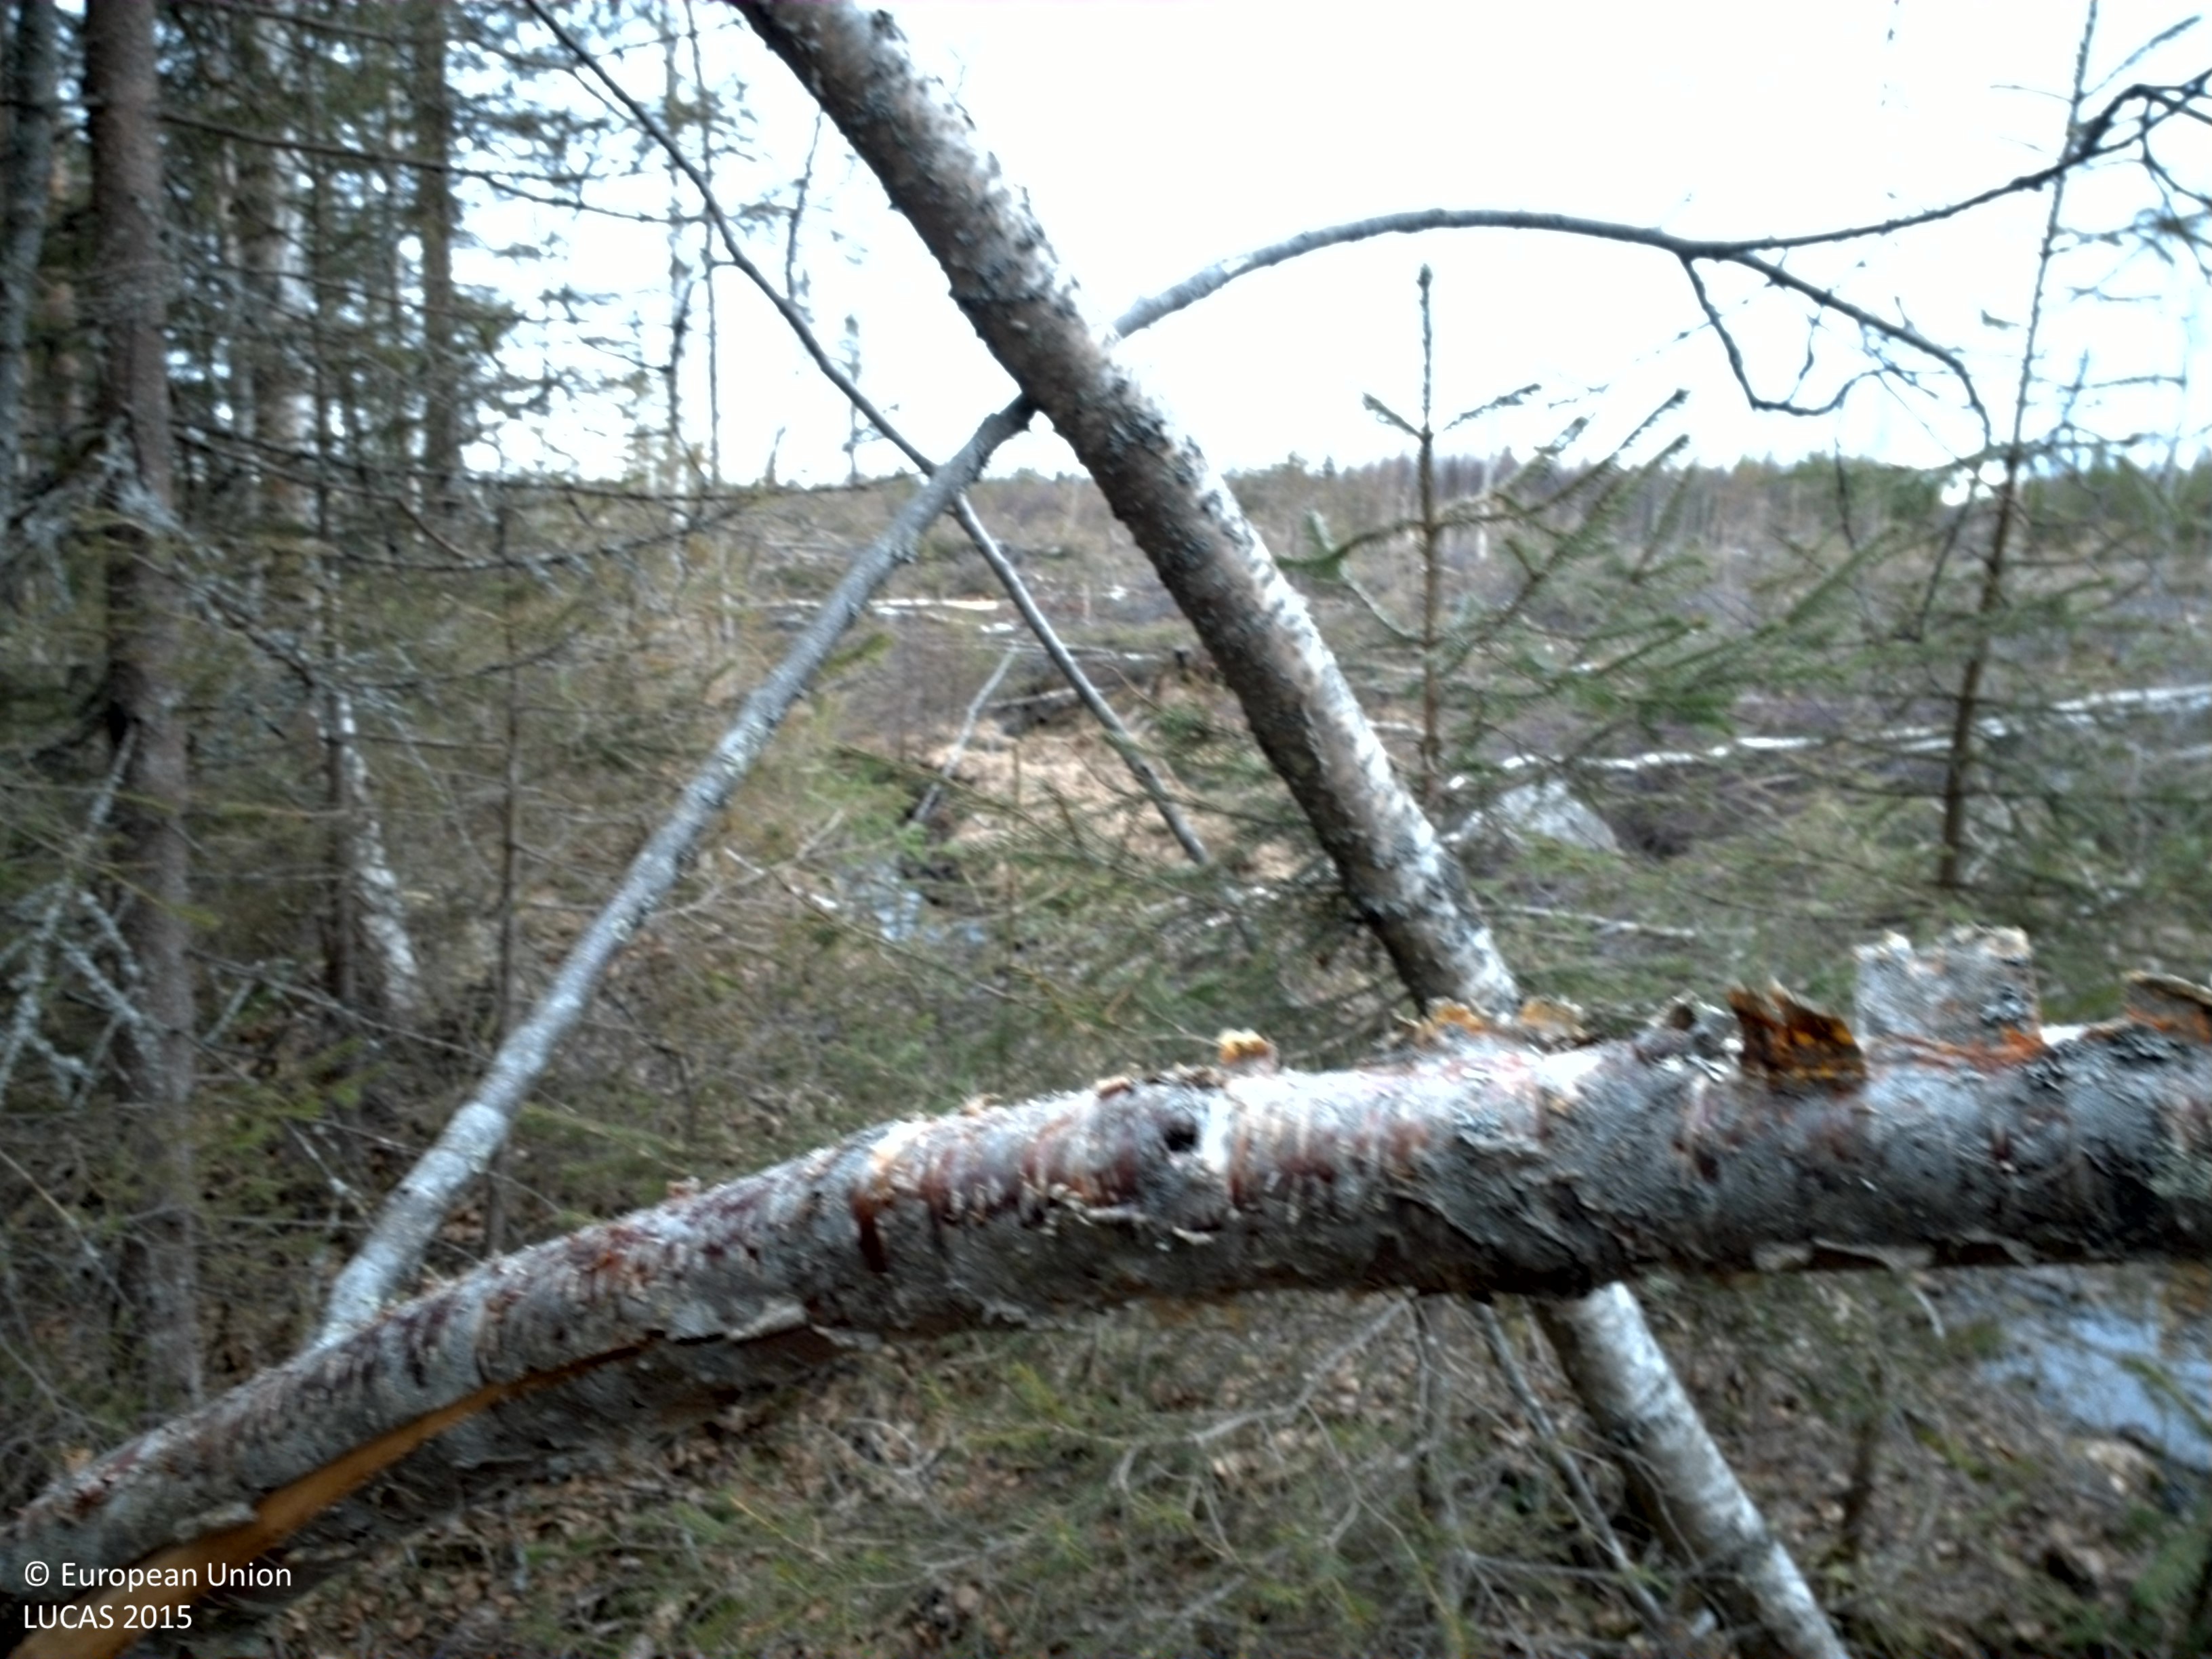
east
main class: Woodland
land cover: Pine dominated mixed woodland
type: boreal forest
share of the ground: > 75 %
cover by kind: coniferous forest trees 60 %, broadleaved forest trees 20 %, herbaceous plants 15 %, shrubs 5 %
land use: Forestry
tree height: > 5 m
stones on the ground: < 10 %
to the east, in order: Pine dominated mixed woodland; Shrubland with sparse tree cover; Broadleaved woodland; Ditches and canals; Broadleaved woodland; Ditches and canals; Broadleaved woodland; Pine dominated coniferous woodland
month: May
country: SE
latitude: 65.7661
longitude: 23.0664
